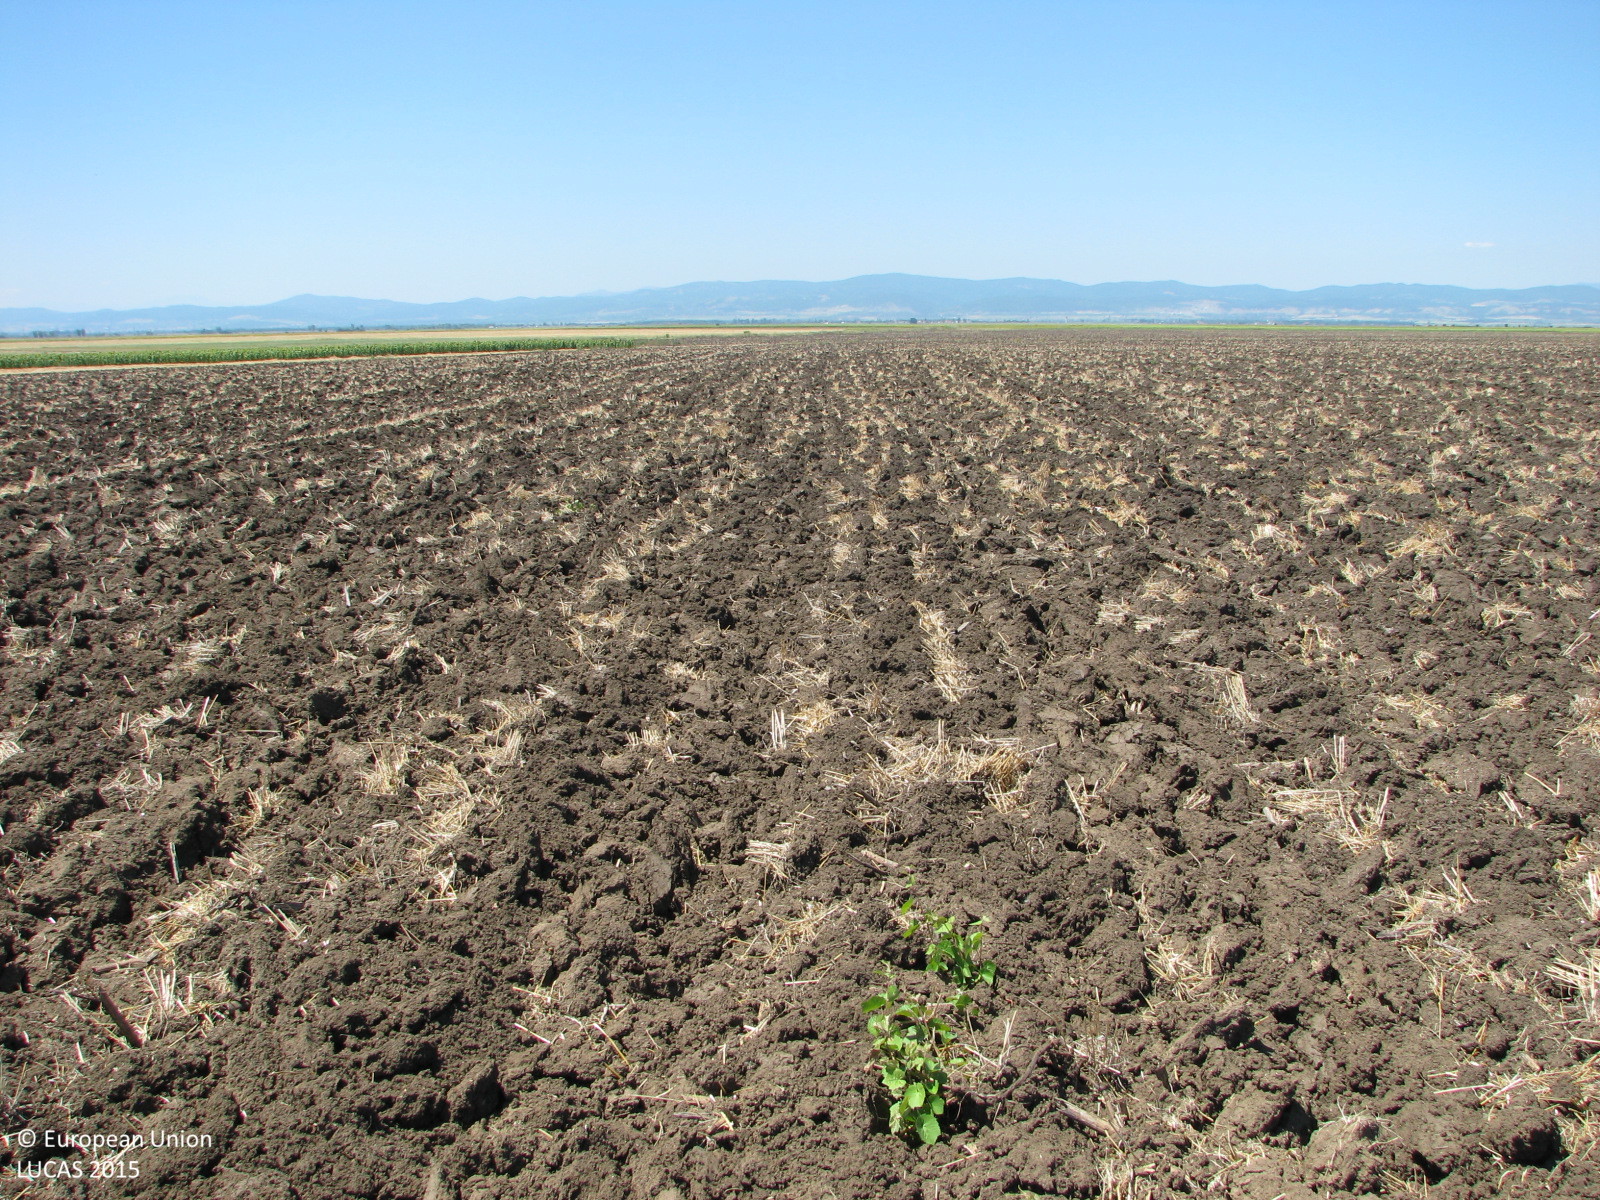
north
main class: Cropland
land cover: Common wheat
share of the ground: < 10 %
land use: Agriculture (excluding fallow land and kitchen gardens)
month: July
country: BG
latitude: 42.3550
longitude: 25.9455
